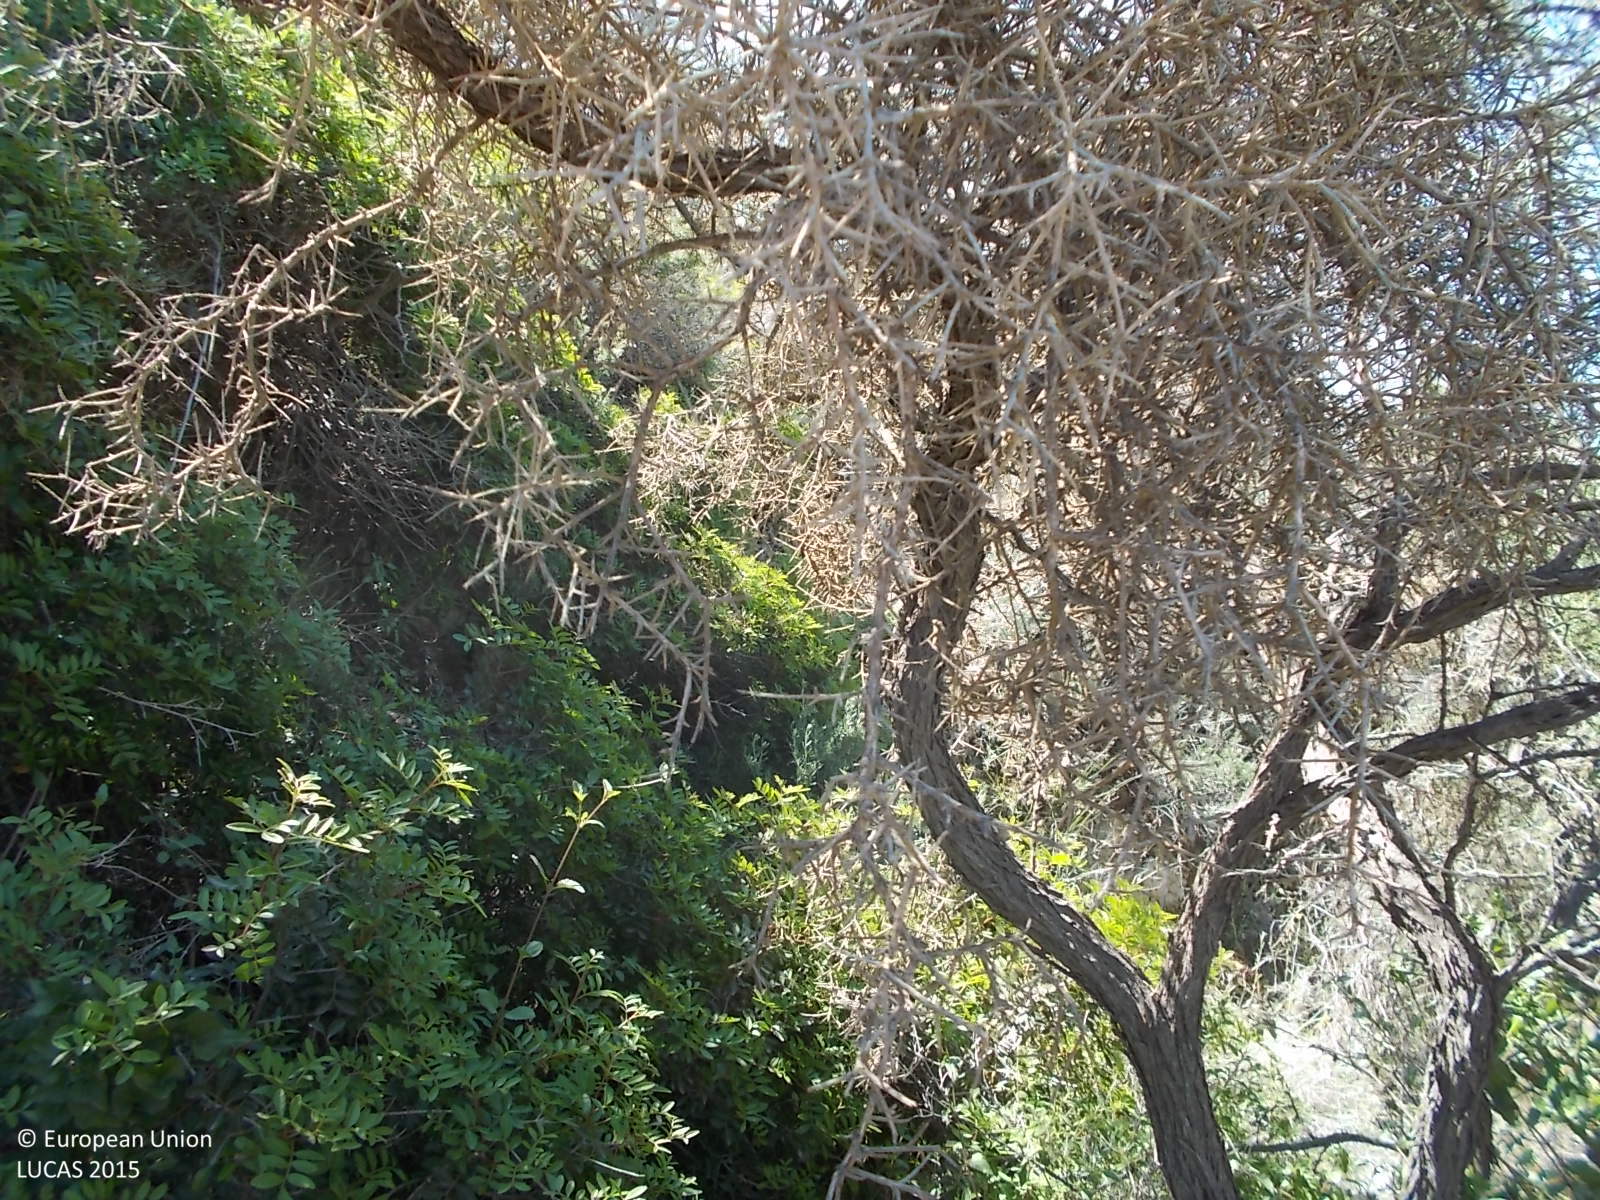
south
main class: Shrubland
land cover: Shrubland without tree cover
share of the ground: > 75 %
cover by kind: shrubs 100 %
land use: Semi-natural and natural areas not in use
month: April
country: CY
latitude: 34.7262
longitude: 33.0448
